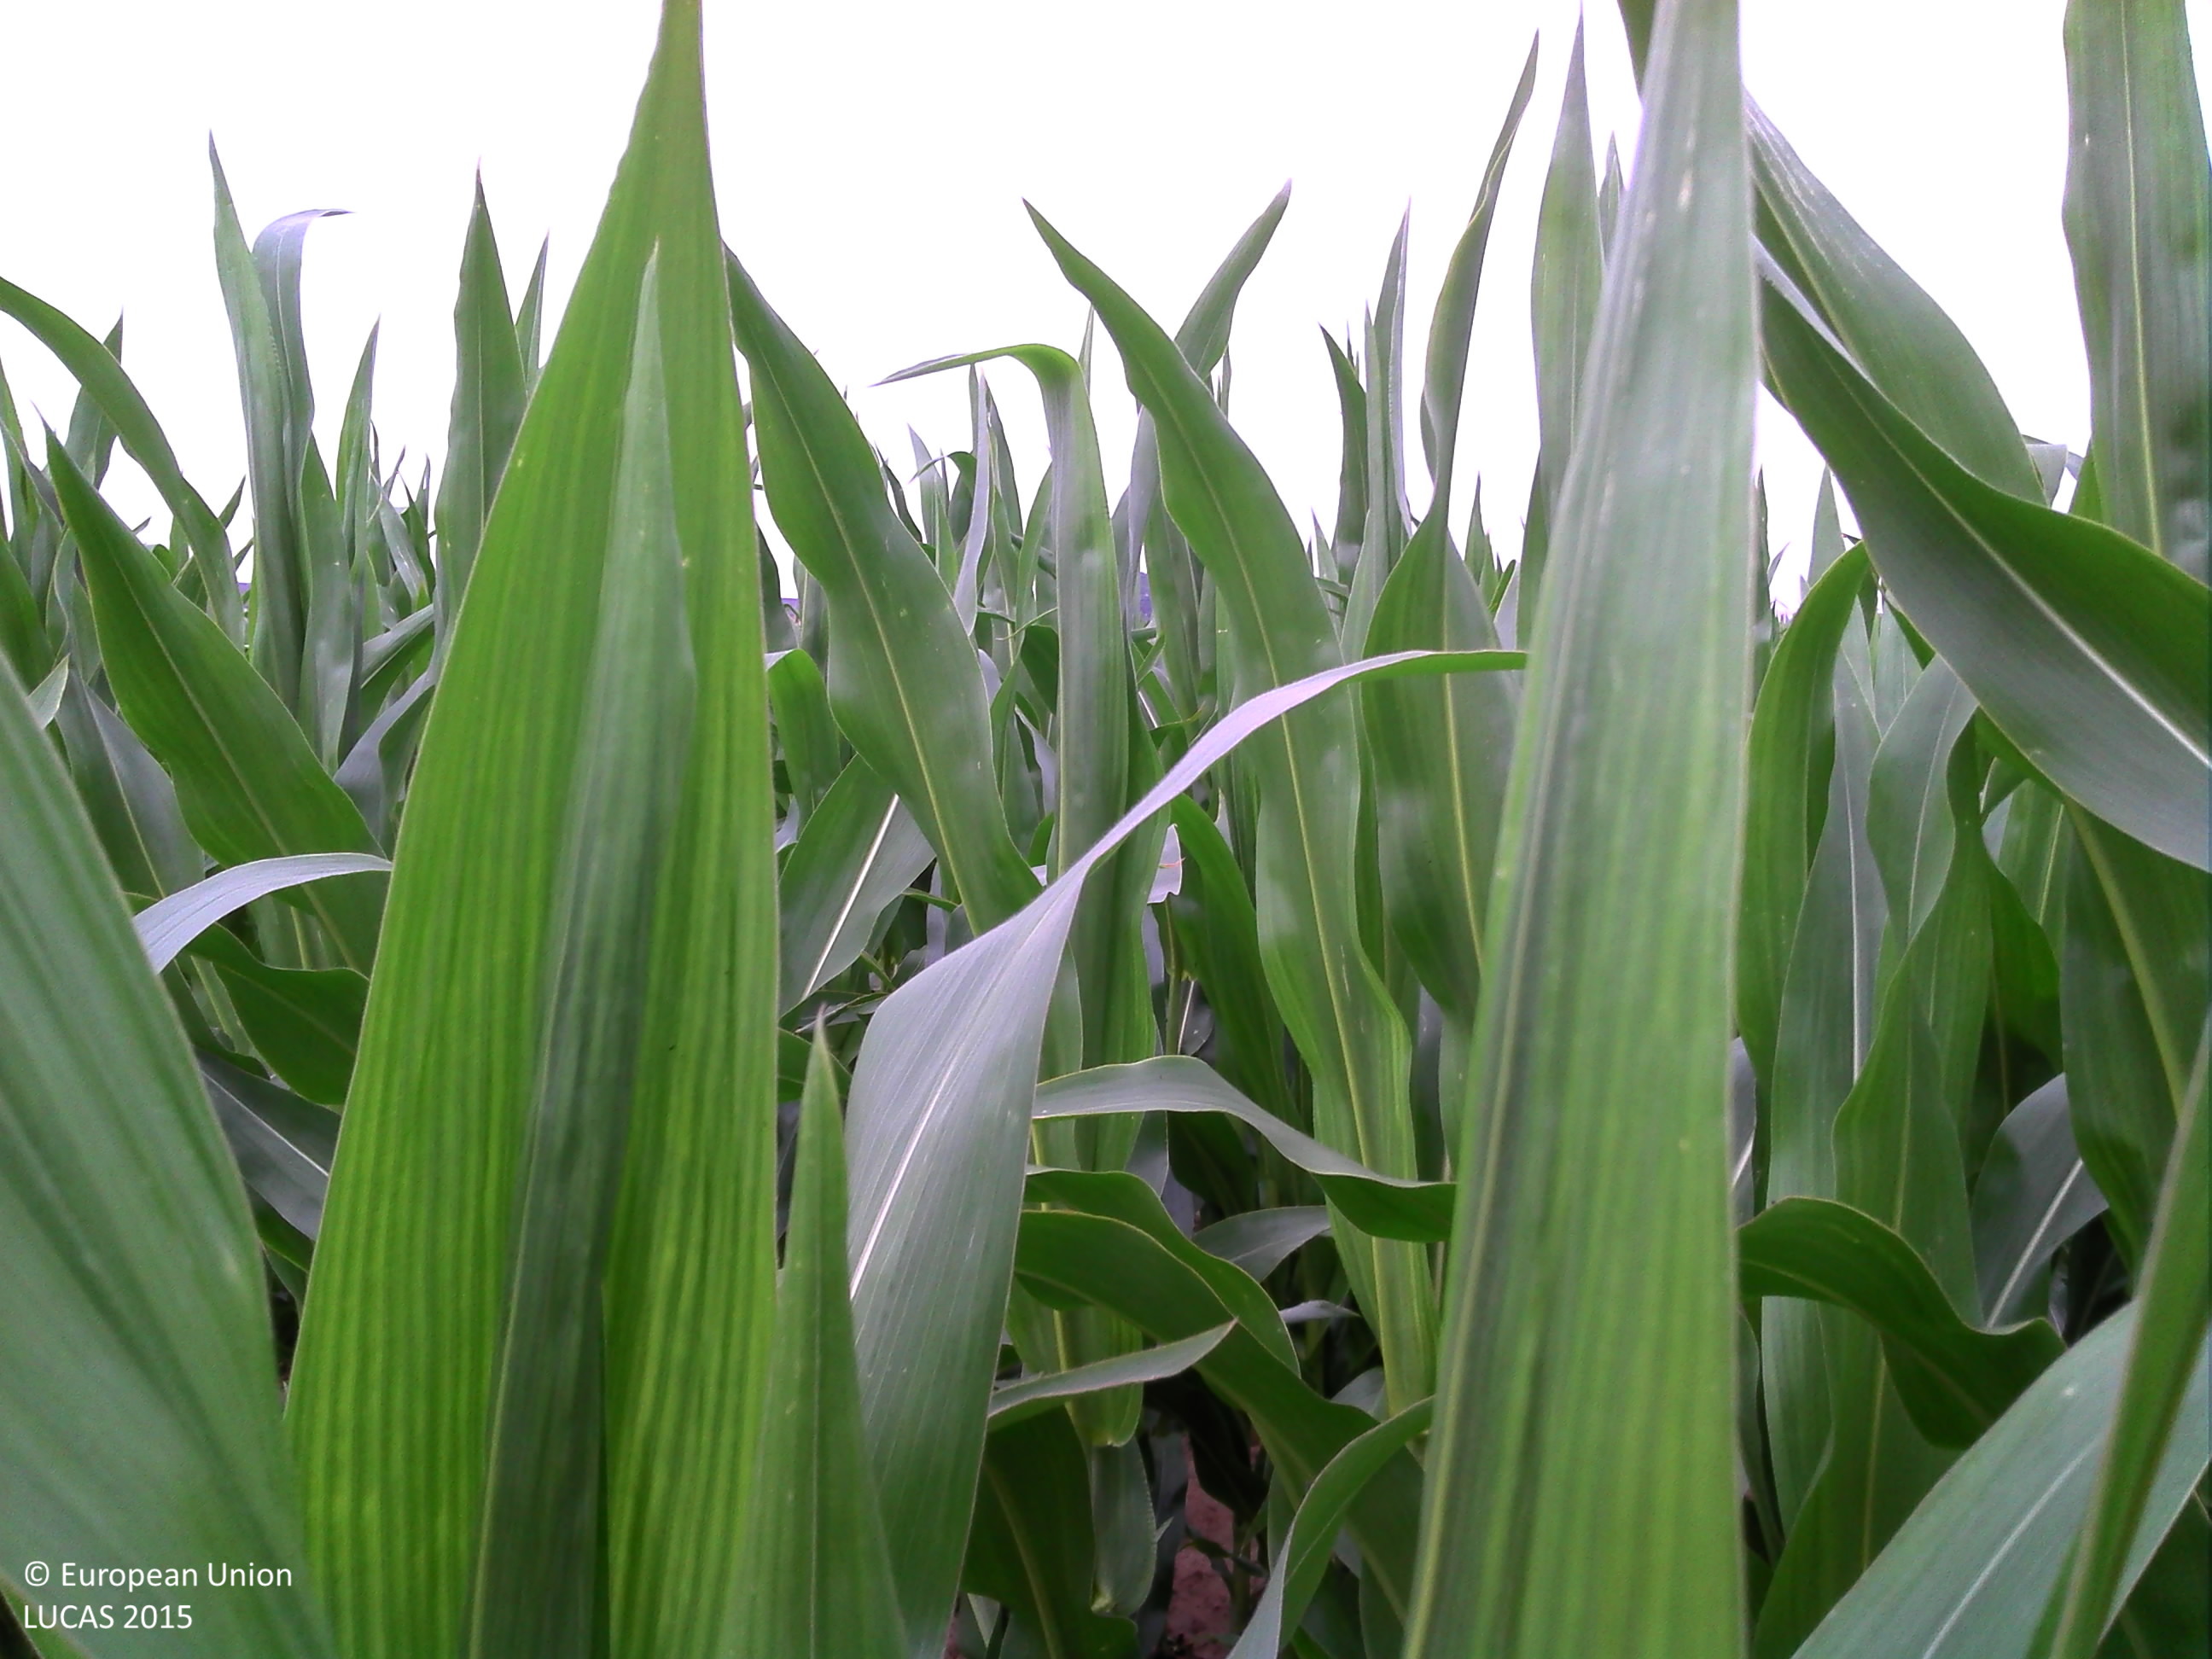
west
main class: Cropland
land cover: Maize
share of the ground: > 75 %
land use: Agriculture (excluding fallow land and kitchen gardens)
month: July
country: BE
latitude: 50.8022
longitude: 5.6139
